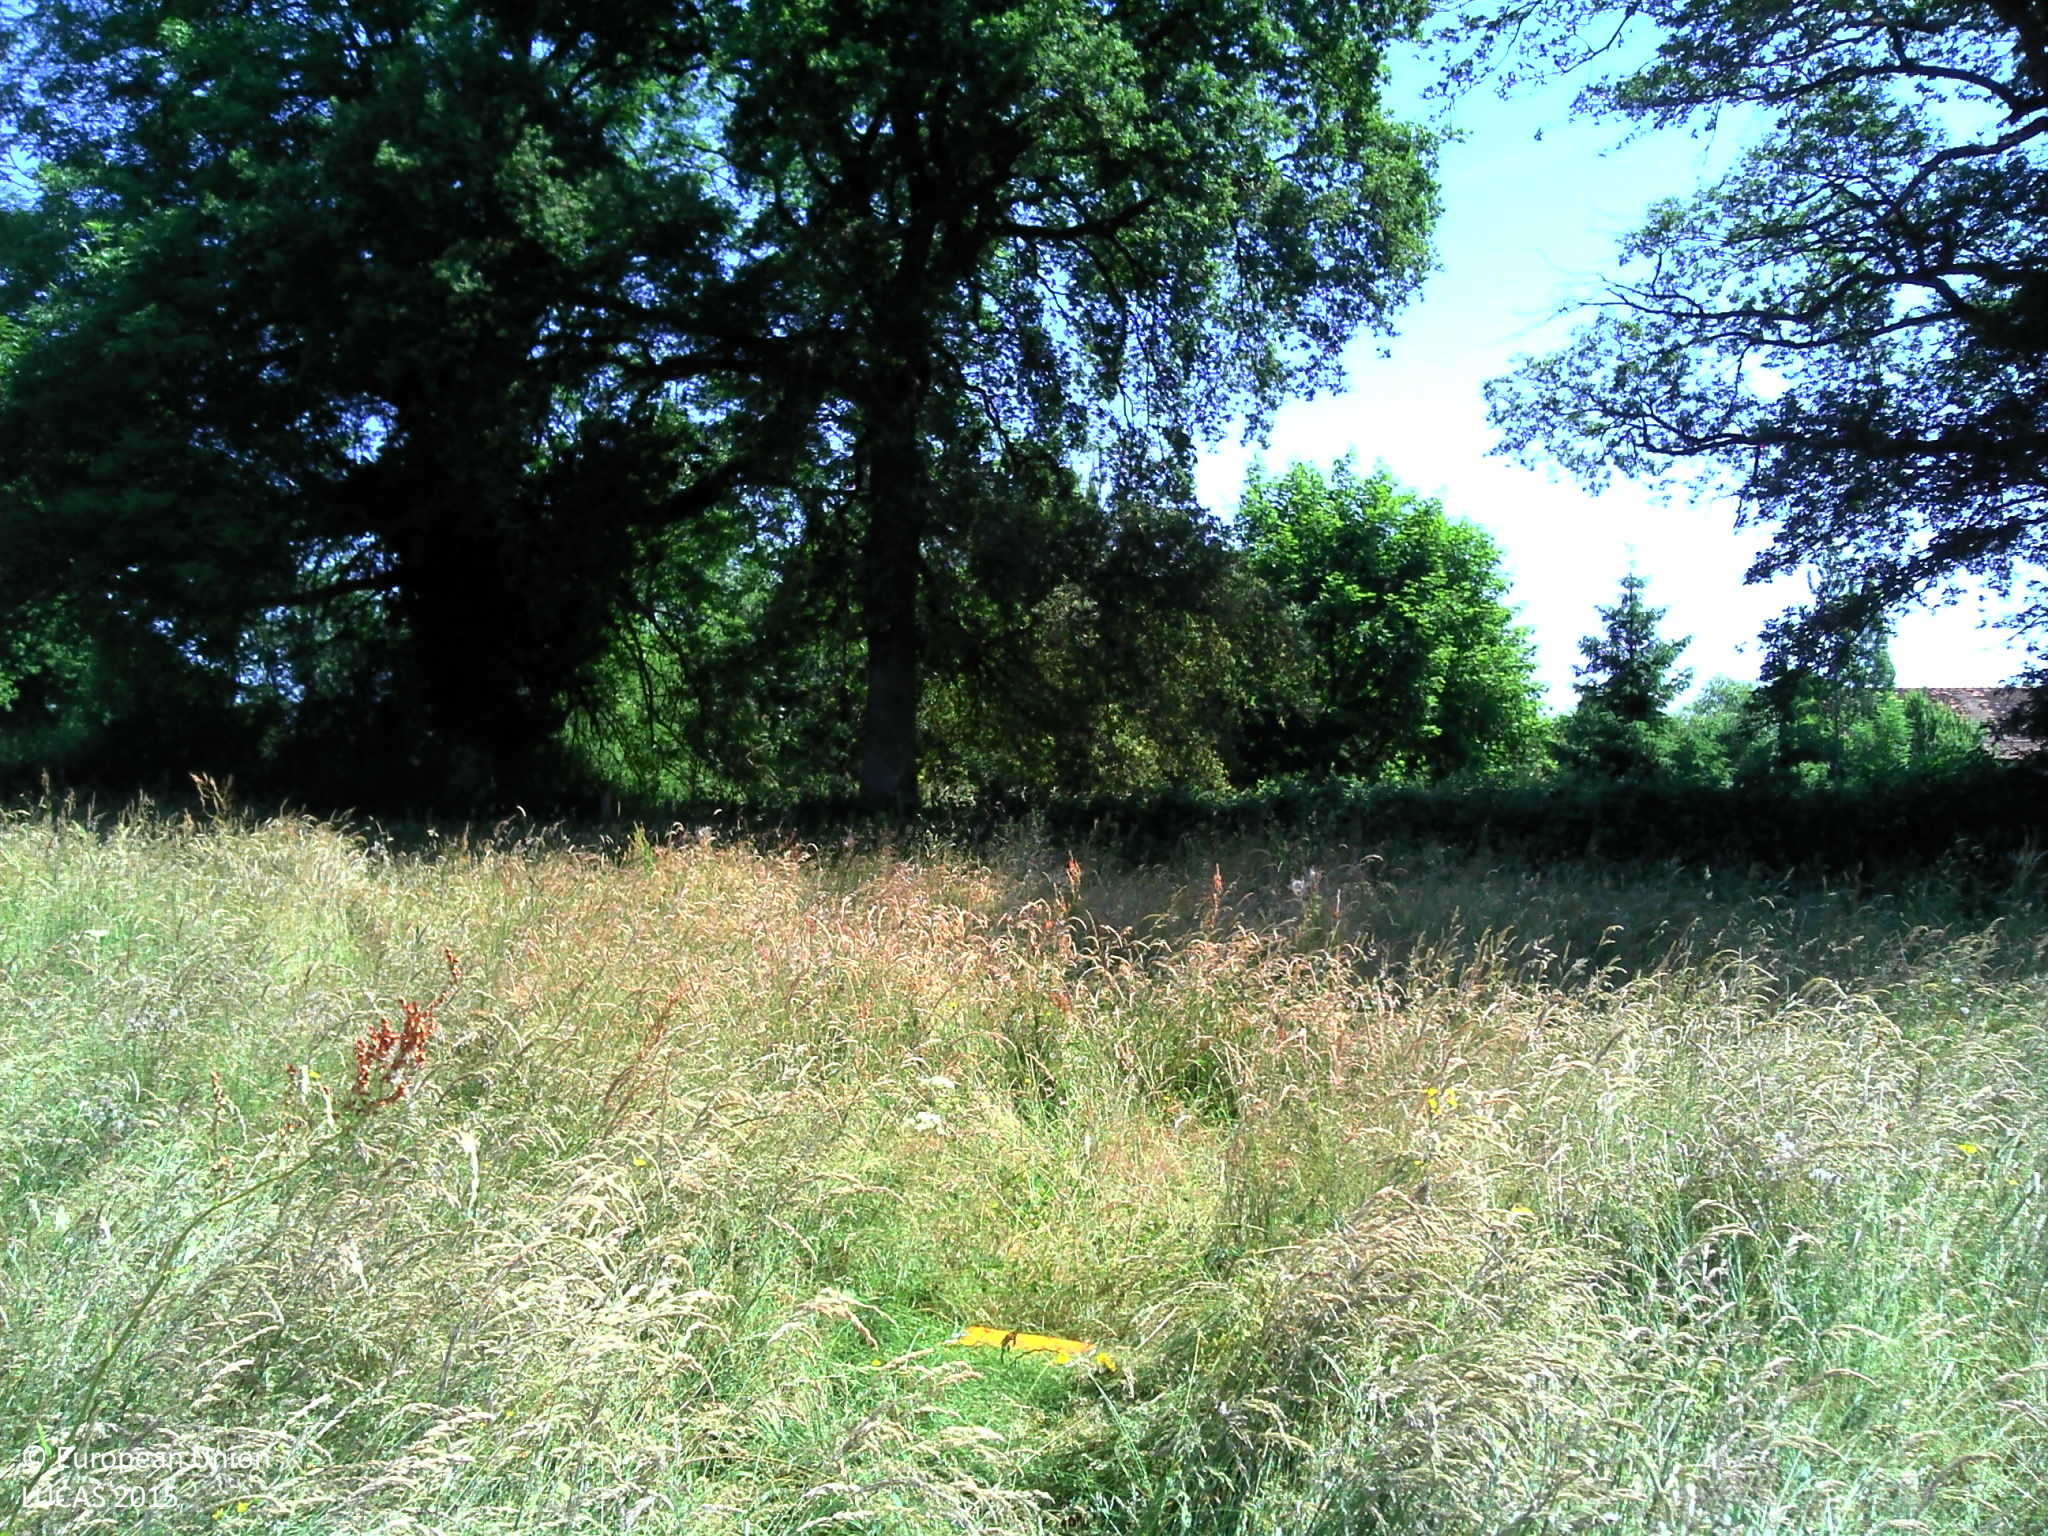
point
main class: Grassland
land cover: Grassland without tree/shrub cover
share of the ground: > 75 %
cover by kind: herbaceous plants 100 %
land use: Agriculture (excluding fallow land and kitchen gardens)
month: June
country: FR
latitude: 46.2726
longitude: 2.8213
